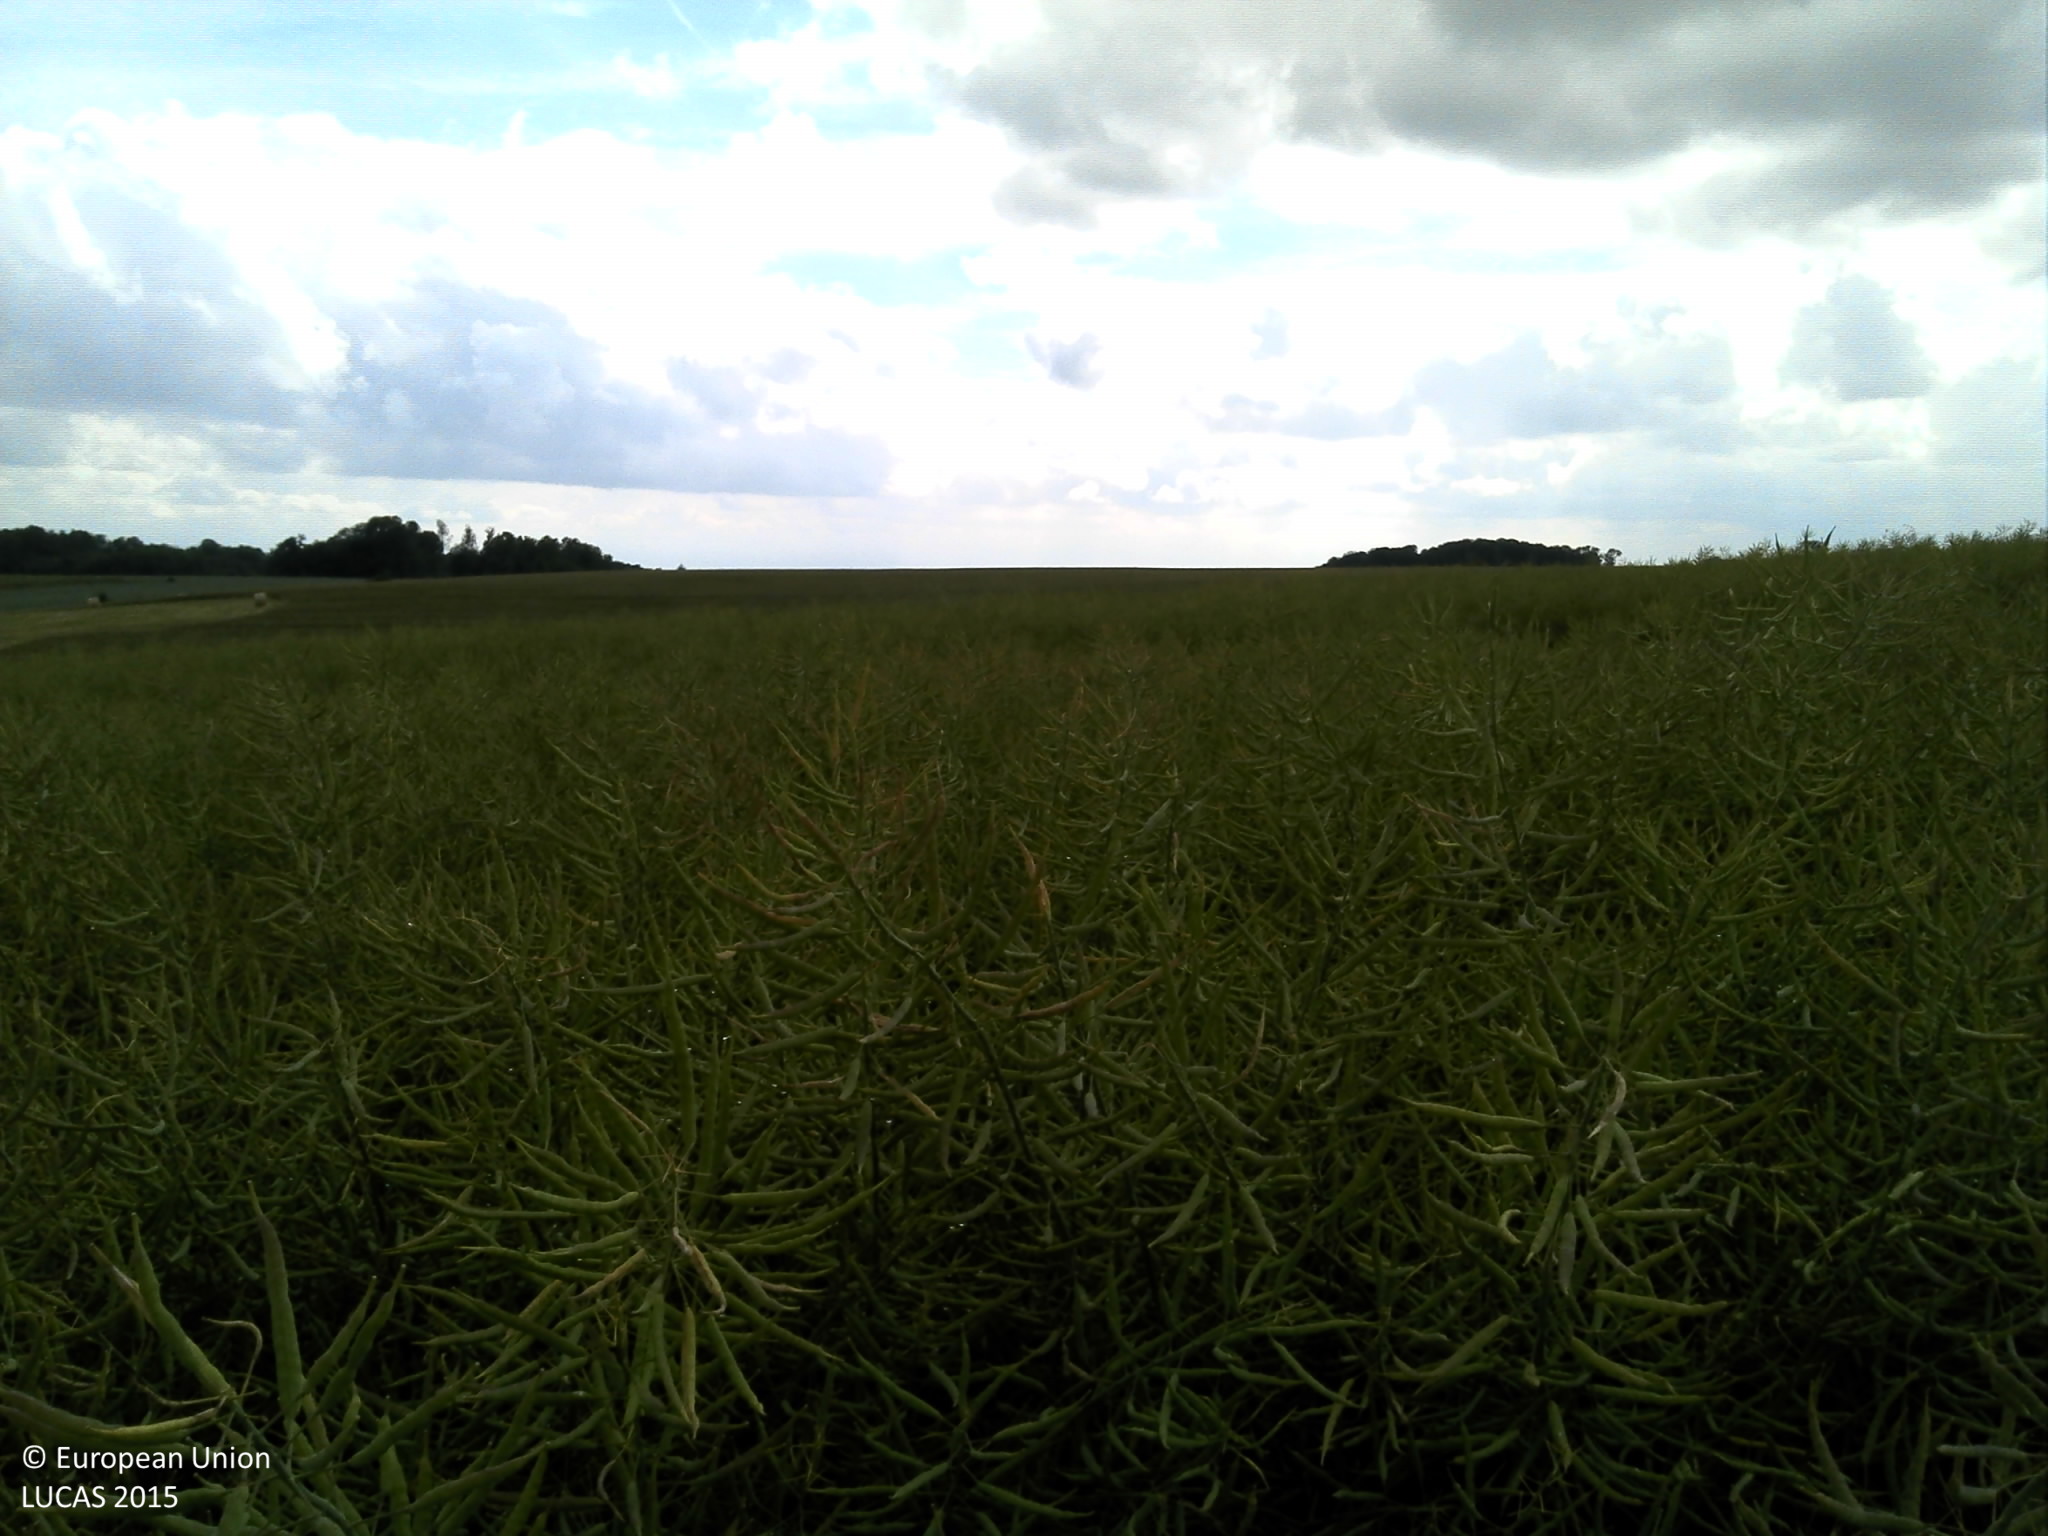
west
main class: Cropland
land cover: Rape and turnip rape
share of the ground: > 75 %
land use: Agriculture (excluding fallow land and kitchen gardens)
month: June
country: FR
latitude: 49.4448
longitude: 5.0185
